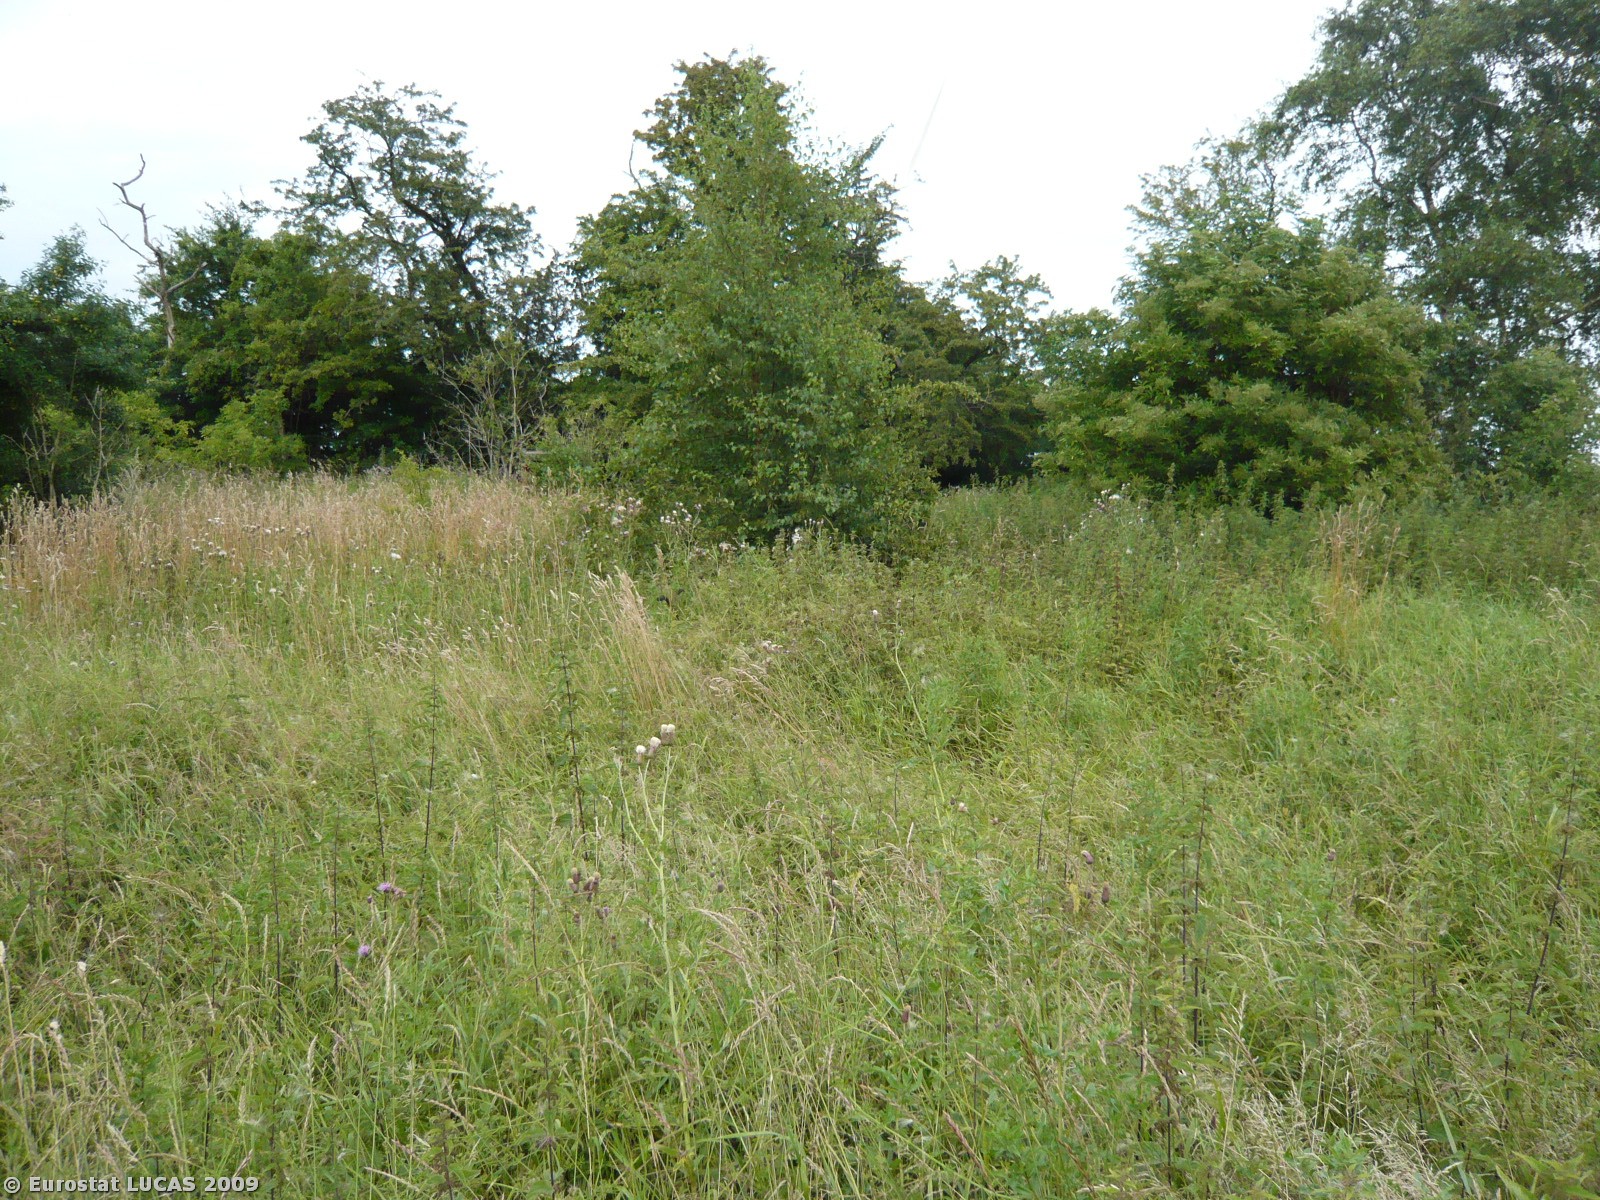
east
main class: Grassland
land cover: Spontaneously vegetated surfaces
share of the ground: > 75 %
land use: Residential
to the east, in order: Spontaneously vegetated surfaces; Grassland with sparse tree/shrub cover; Broadleaved woodland; Tracks; Grassland without tree/shrub cover; Barley; Spontaneously vegetated surfaces; Artificial constructions in urban areas; Common wheat
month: July
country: DK
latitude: 55.8994
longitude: 12.1890
